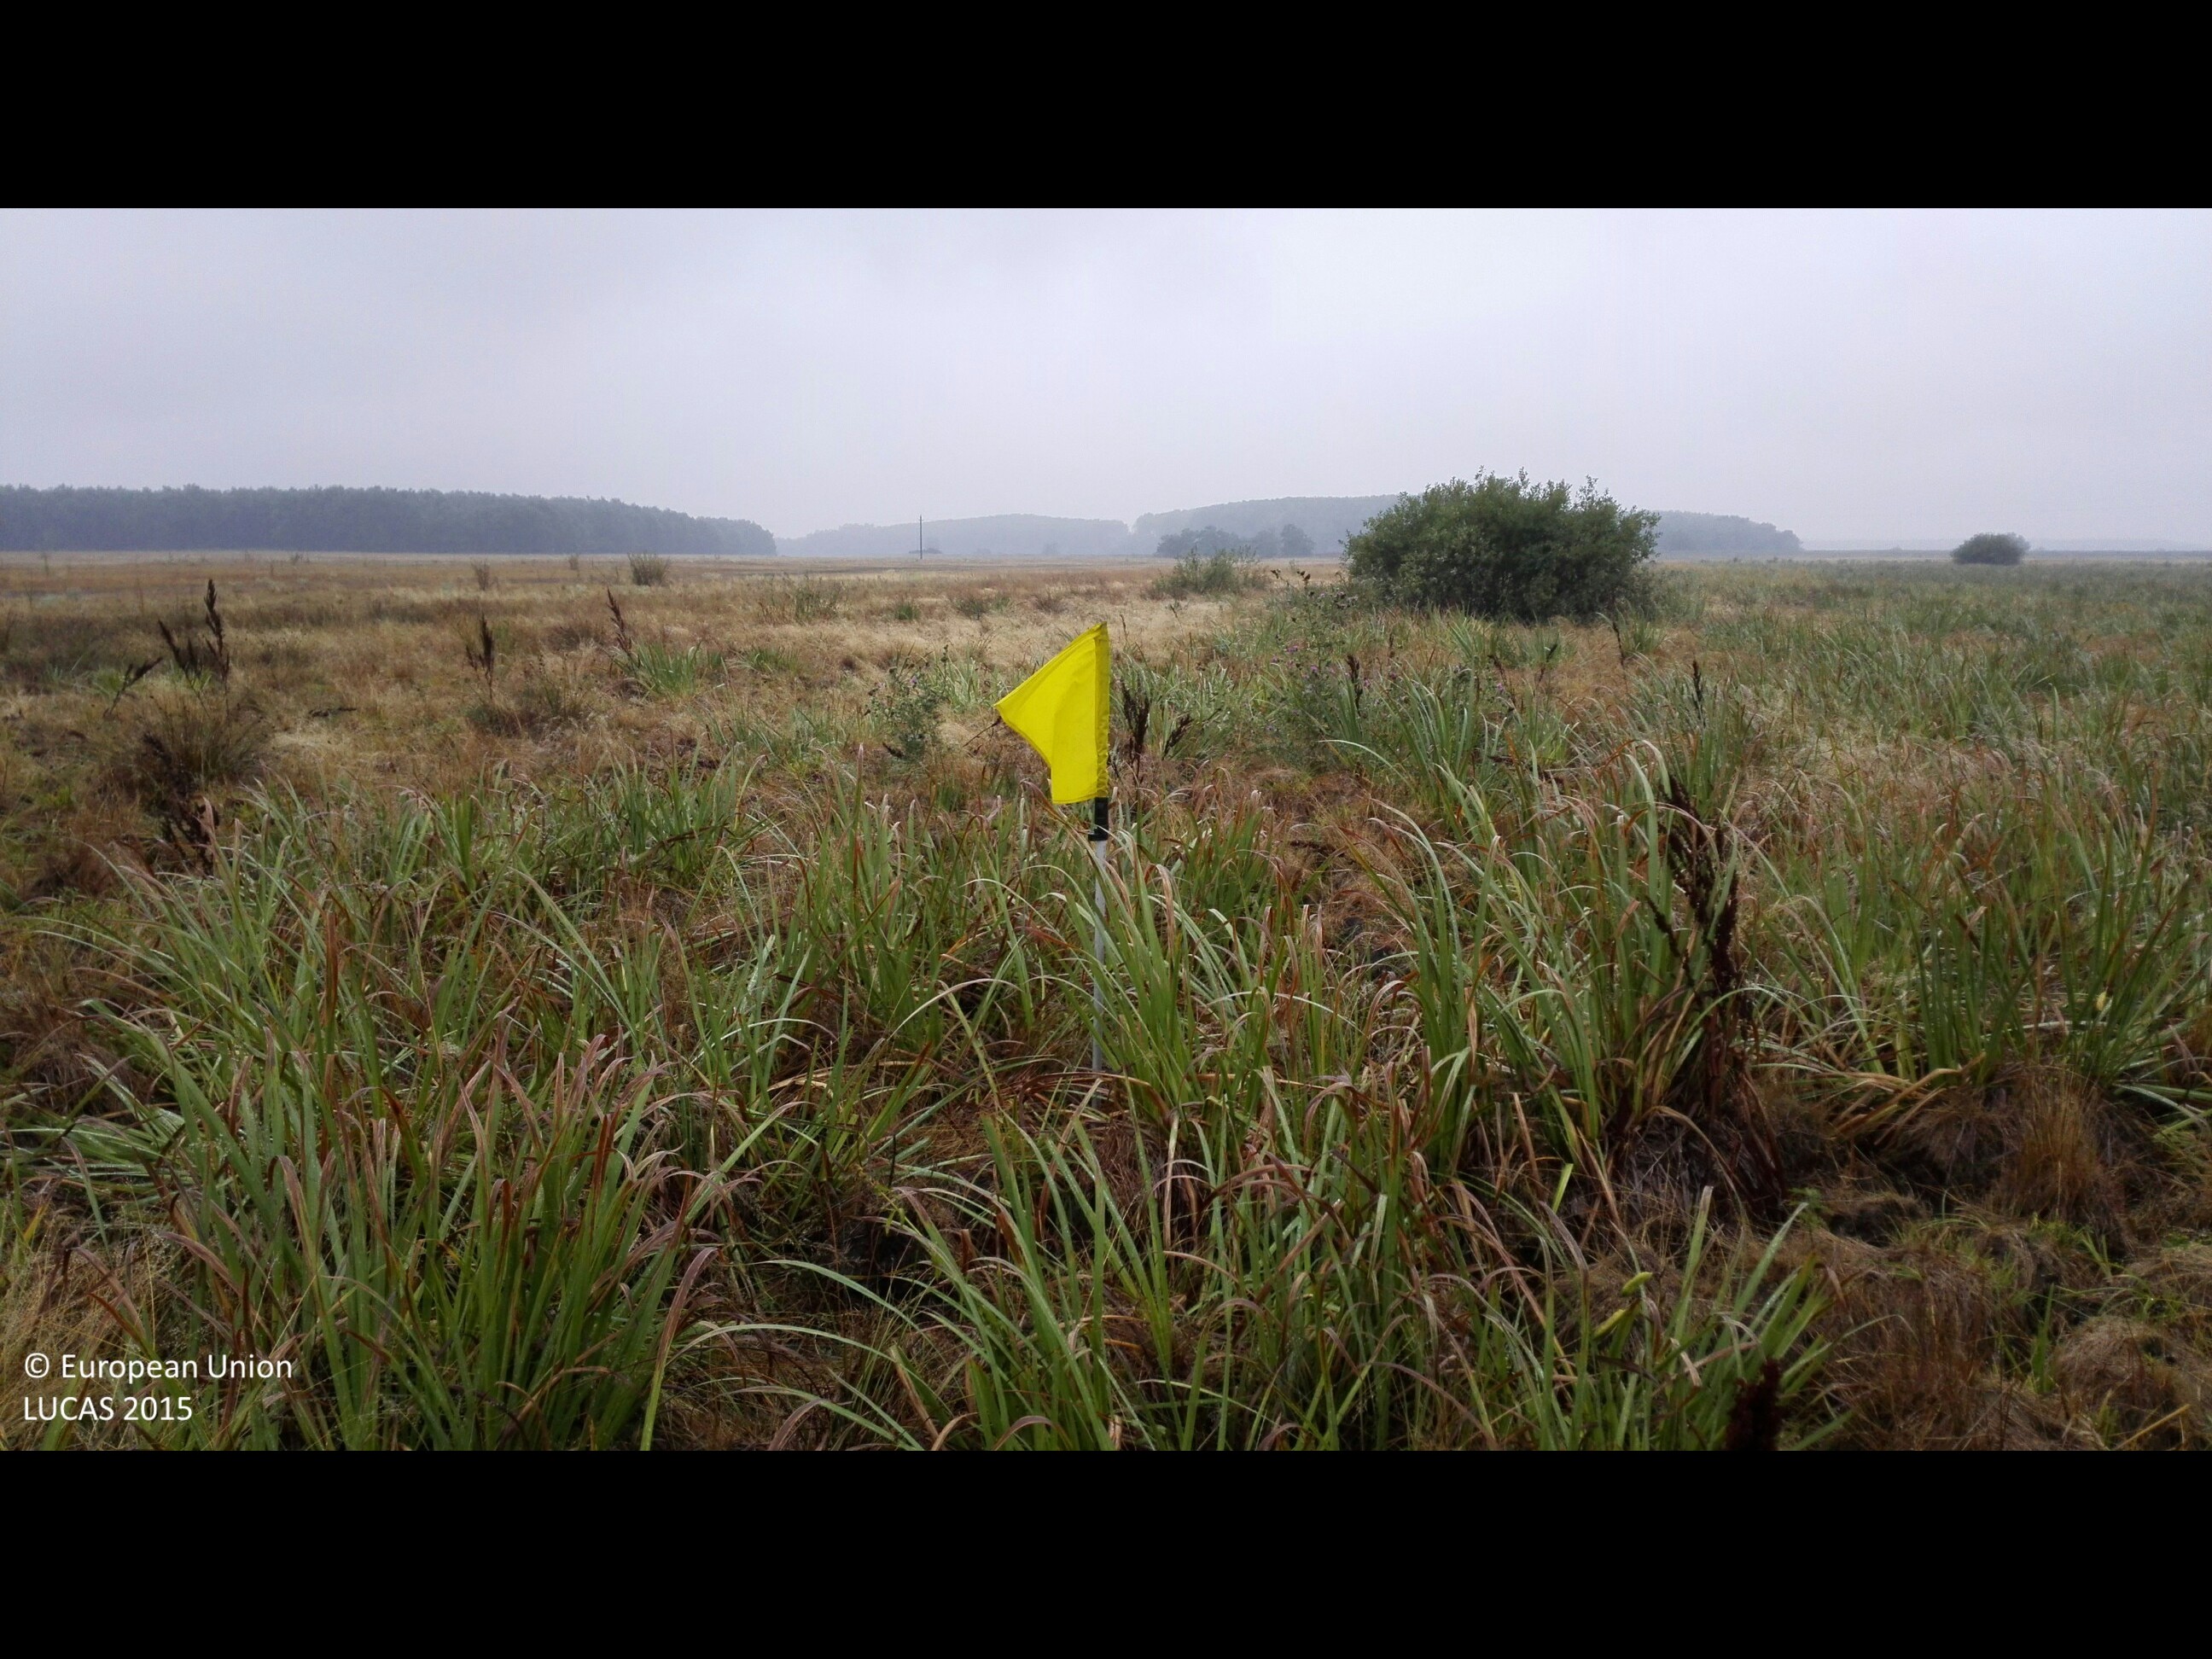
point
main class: Grassland
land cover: Spontaneously vegetated surfaces
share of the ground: > 75 %
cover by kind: herbaceous plants 100 %
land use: Agriculture (excluding fallow land and kitchen gardens)
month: August
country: HU
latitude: 47.2094
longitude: 21.5950
